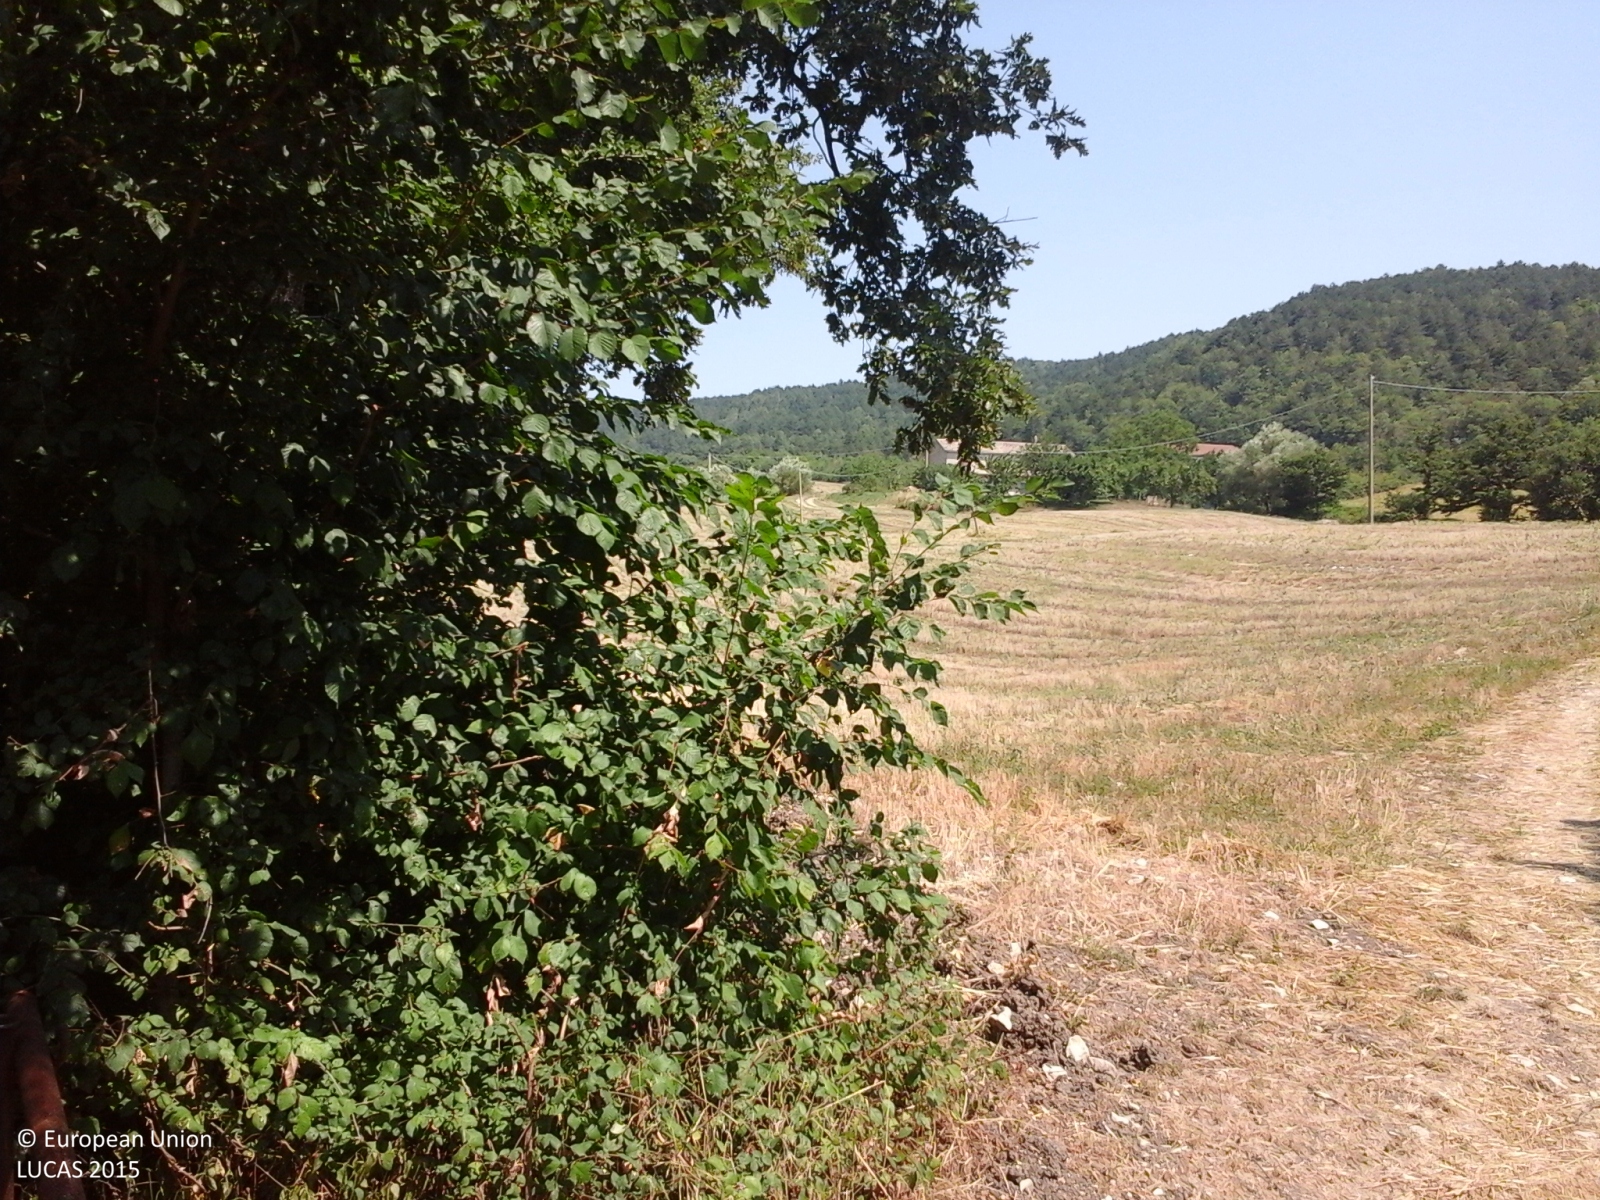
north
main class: Cropland
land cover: Durum wheat
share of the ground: > 75 %
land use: Agriculture (excluding fallow land and kitchen gardens)
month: August
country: IT
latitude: 41.3460
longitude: 15.1569
